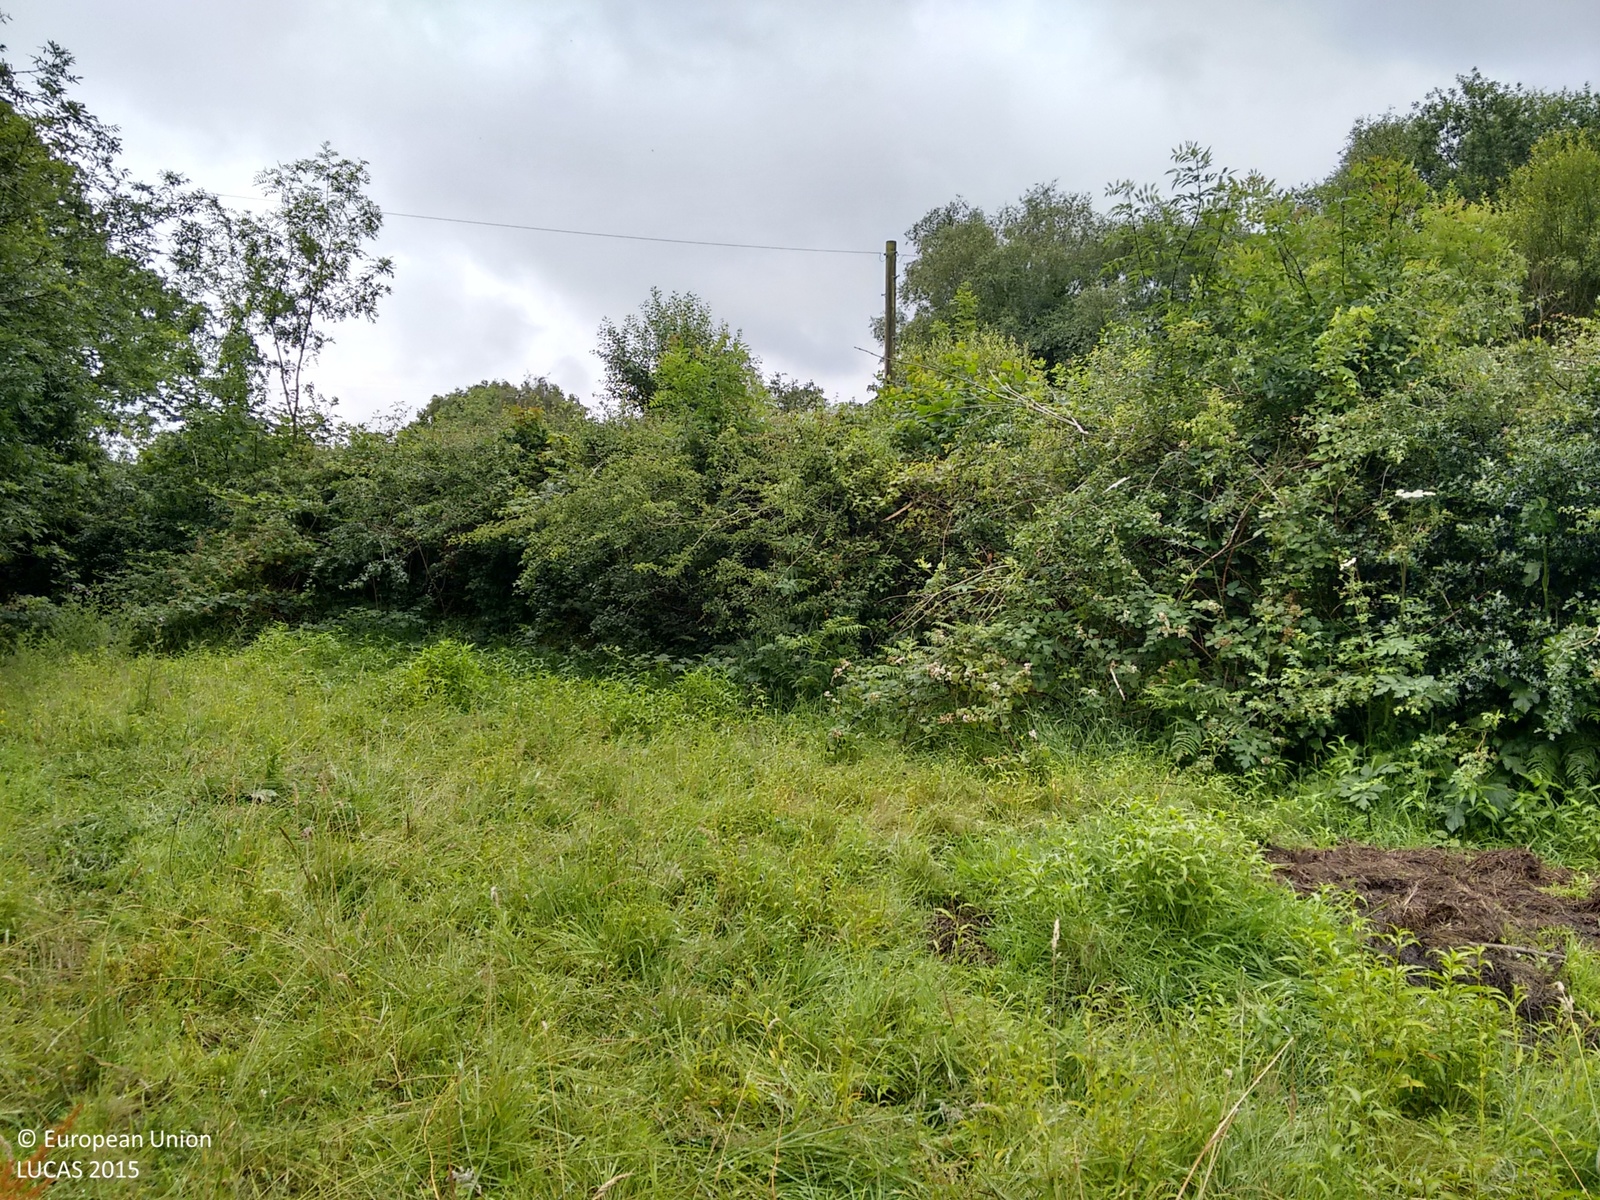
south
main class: Grassland
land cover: Grassland without tree/shrub cover
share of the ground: > 75 %
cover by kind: herbaceous plants 100 %
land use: Agriculture (excluding fallow land and kitchen gardens)
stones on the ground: < 10 %
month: July
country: GB
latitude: 51.6917
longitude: -3.8195
